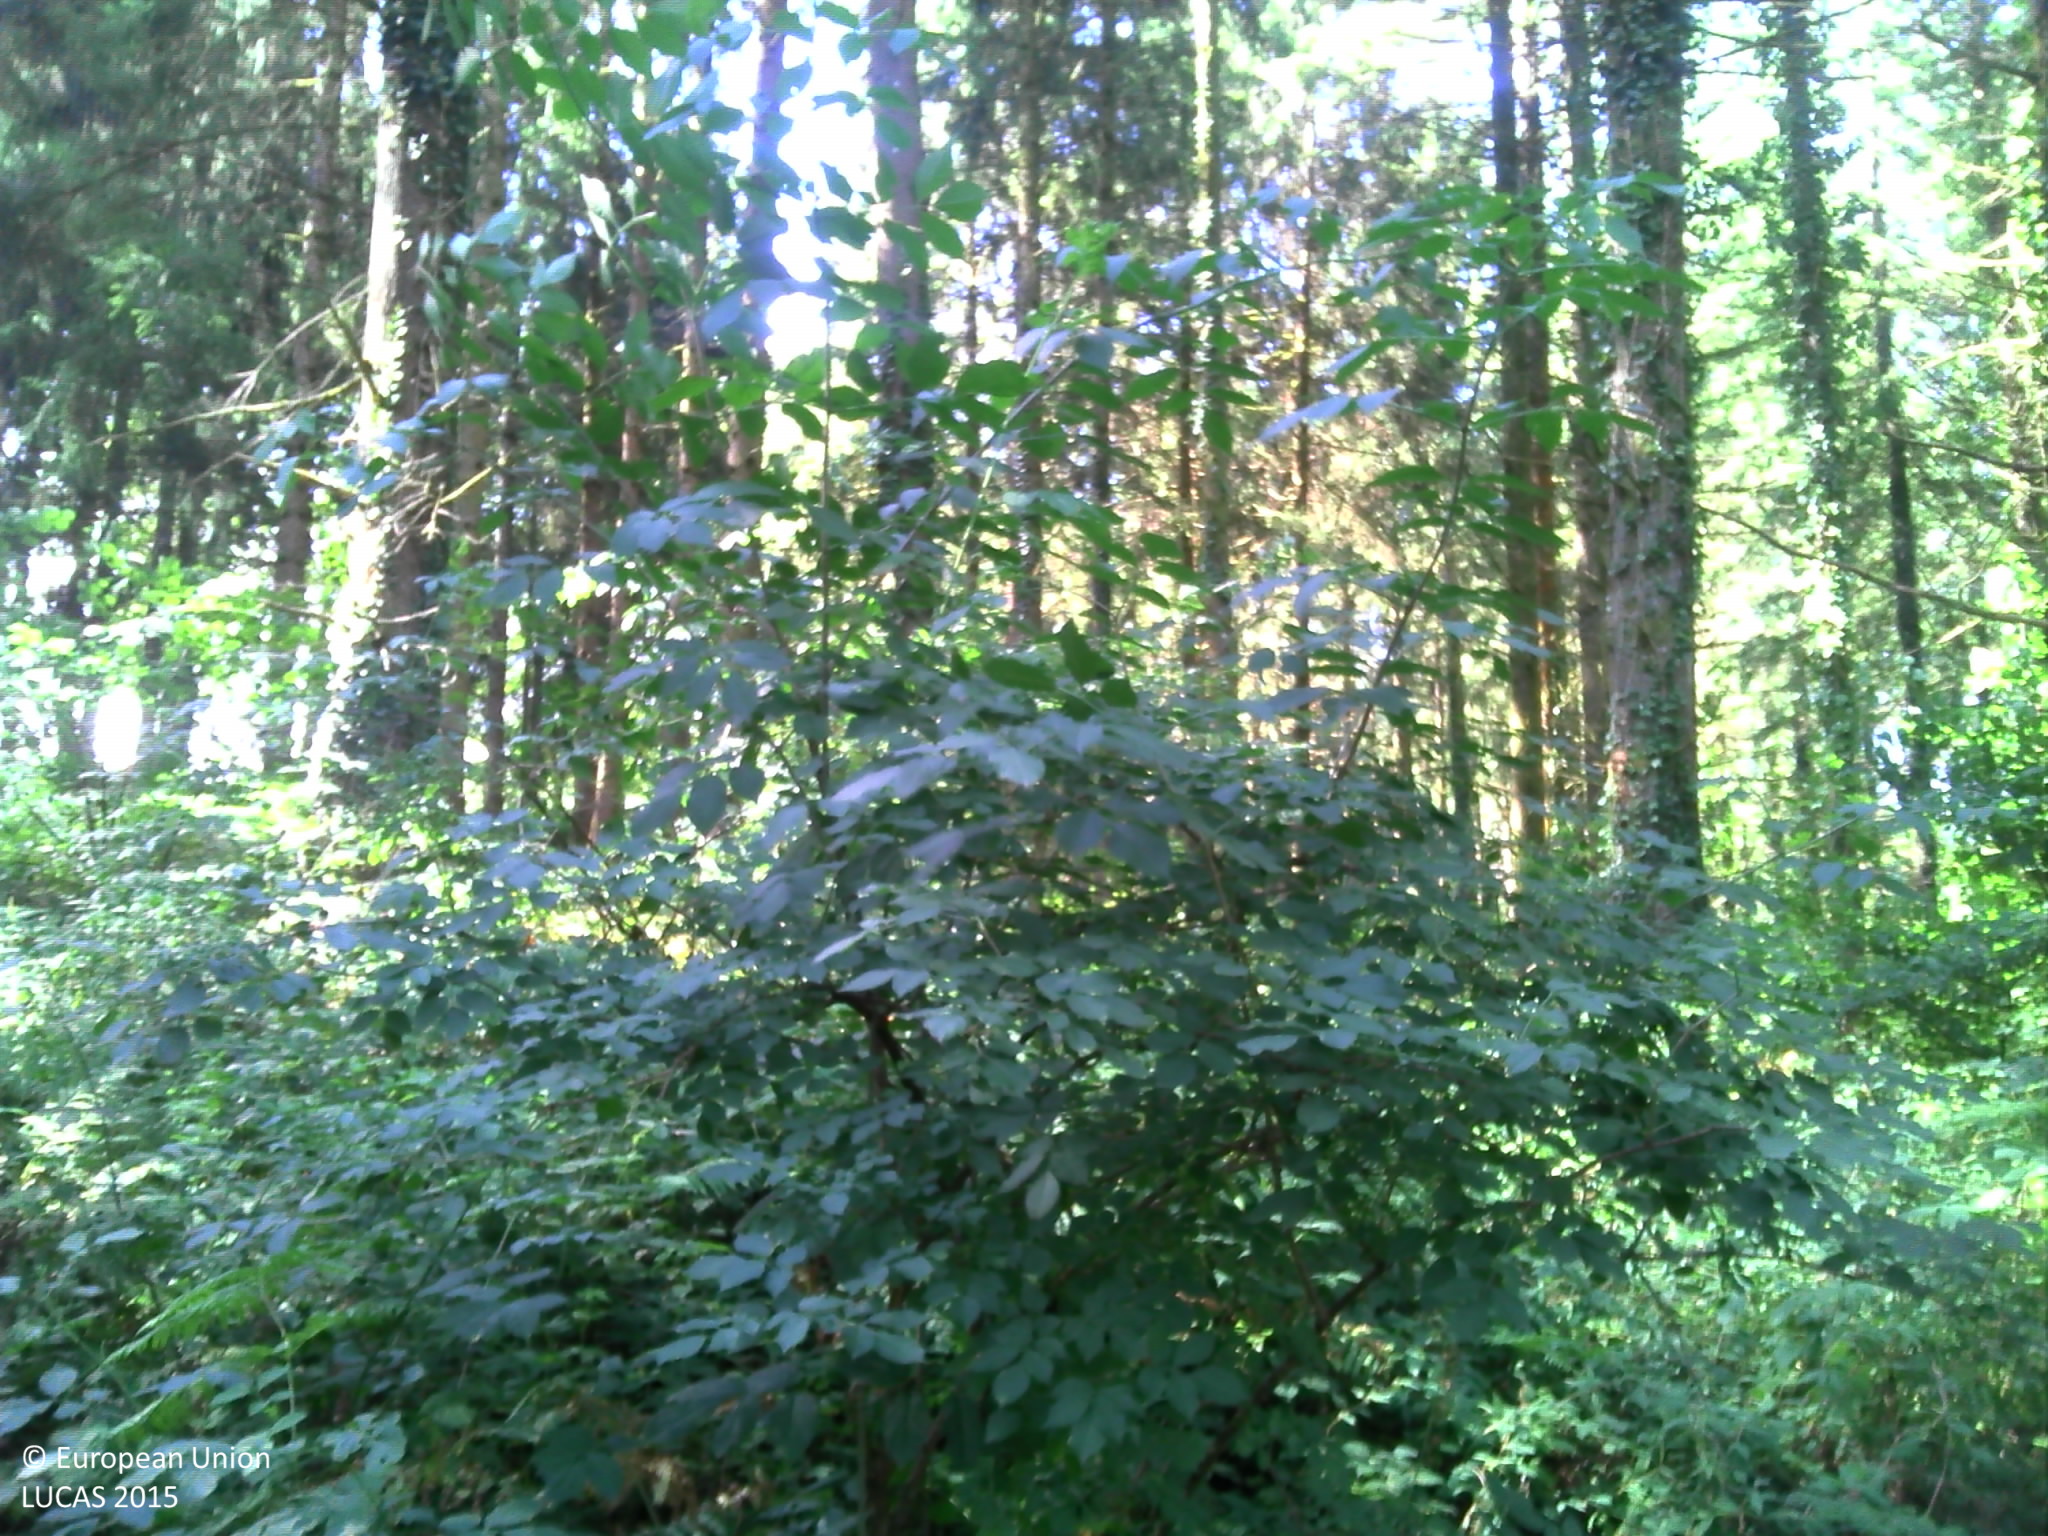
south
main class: Woodland
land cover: Spruce dominated coniferous woodland
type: exotic forest
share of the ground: > 75 %
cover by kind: coniferous forest trees 80 %, shrubs 10 %, herbaceous plants 10 %
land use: Forestry
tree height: > 5 m
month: July
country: FR
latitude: 45.6017
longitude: 1.8024
